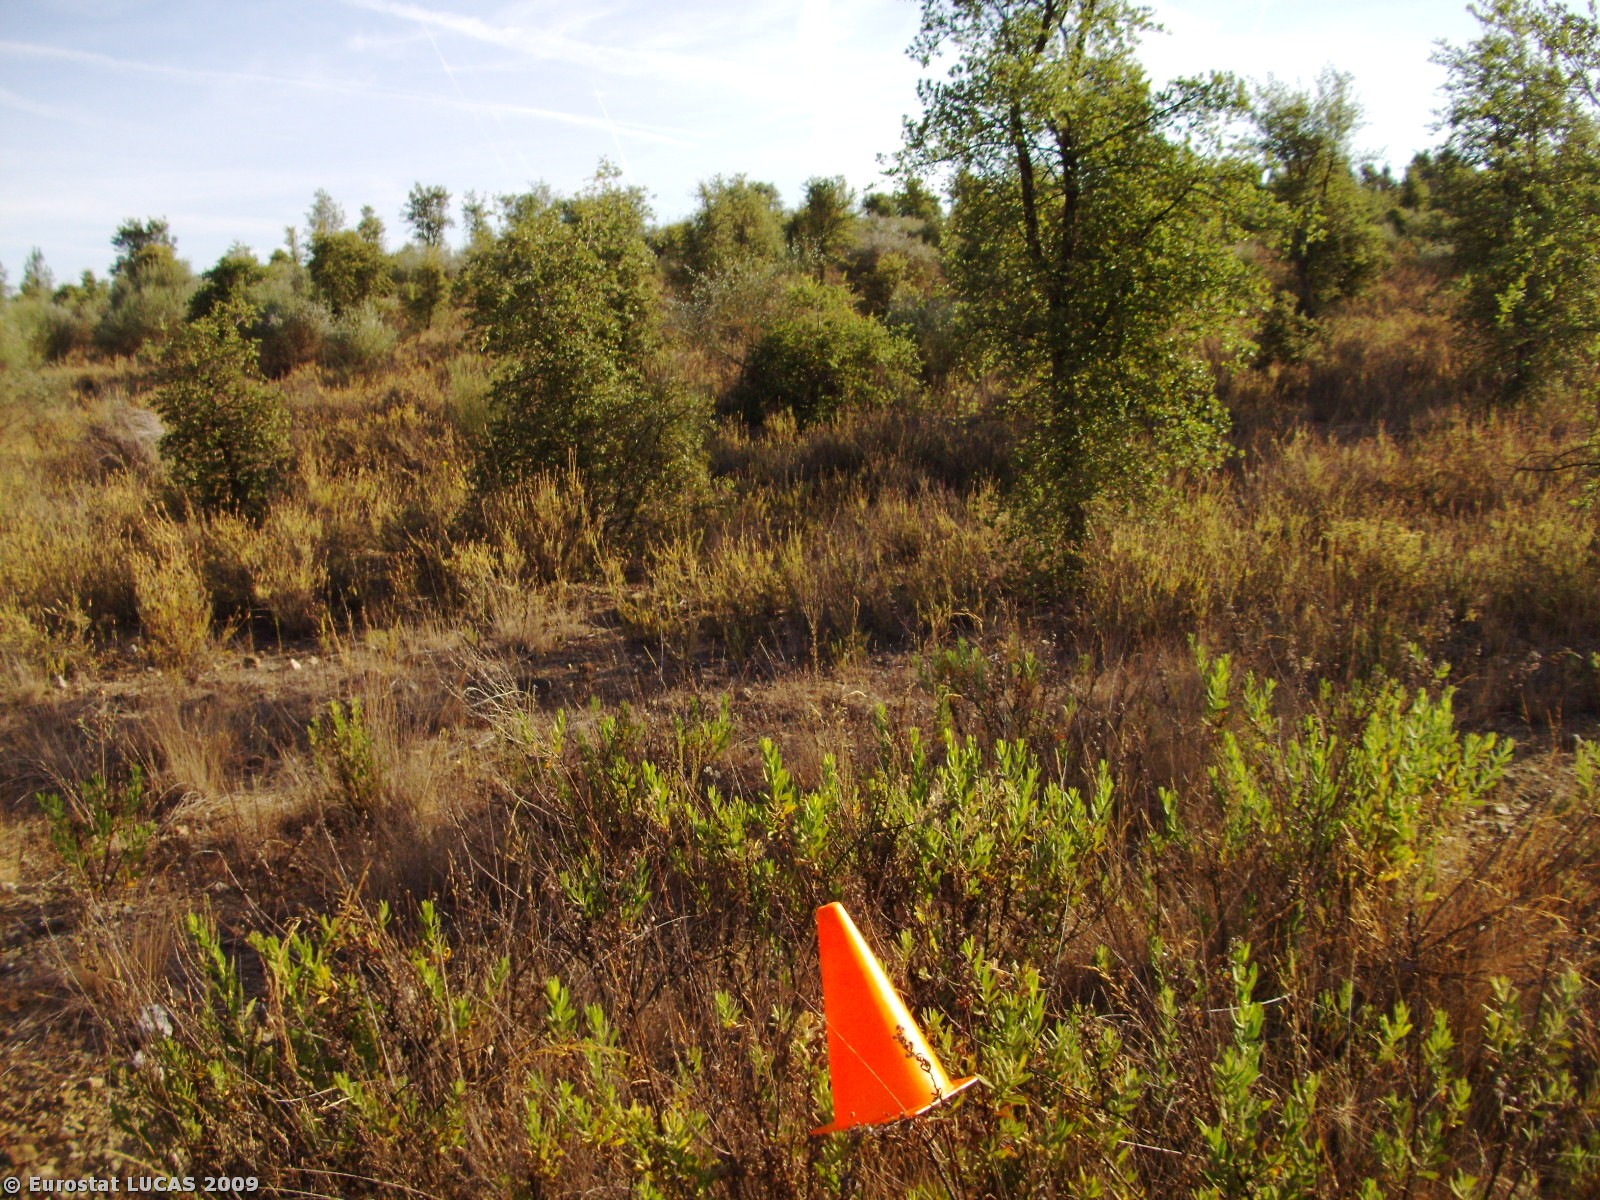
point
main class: Woodland
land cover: Broadleaved woodland
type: broadleaved evergreen forest
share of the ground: 25 - 50 %
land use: Forestry
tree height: > 5 m
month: June
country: PT
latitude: 40.0903
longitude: -7.2572
